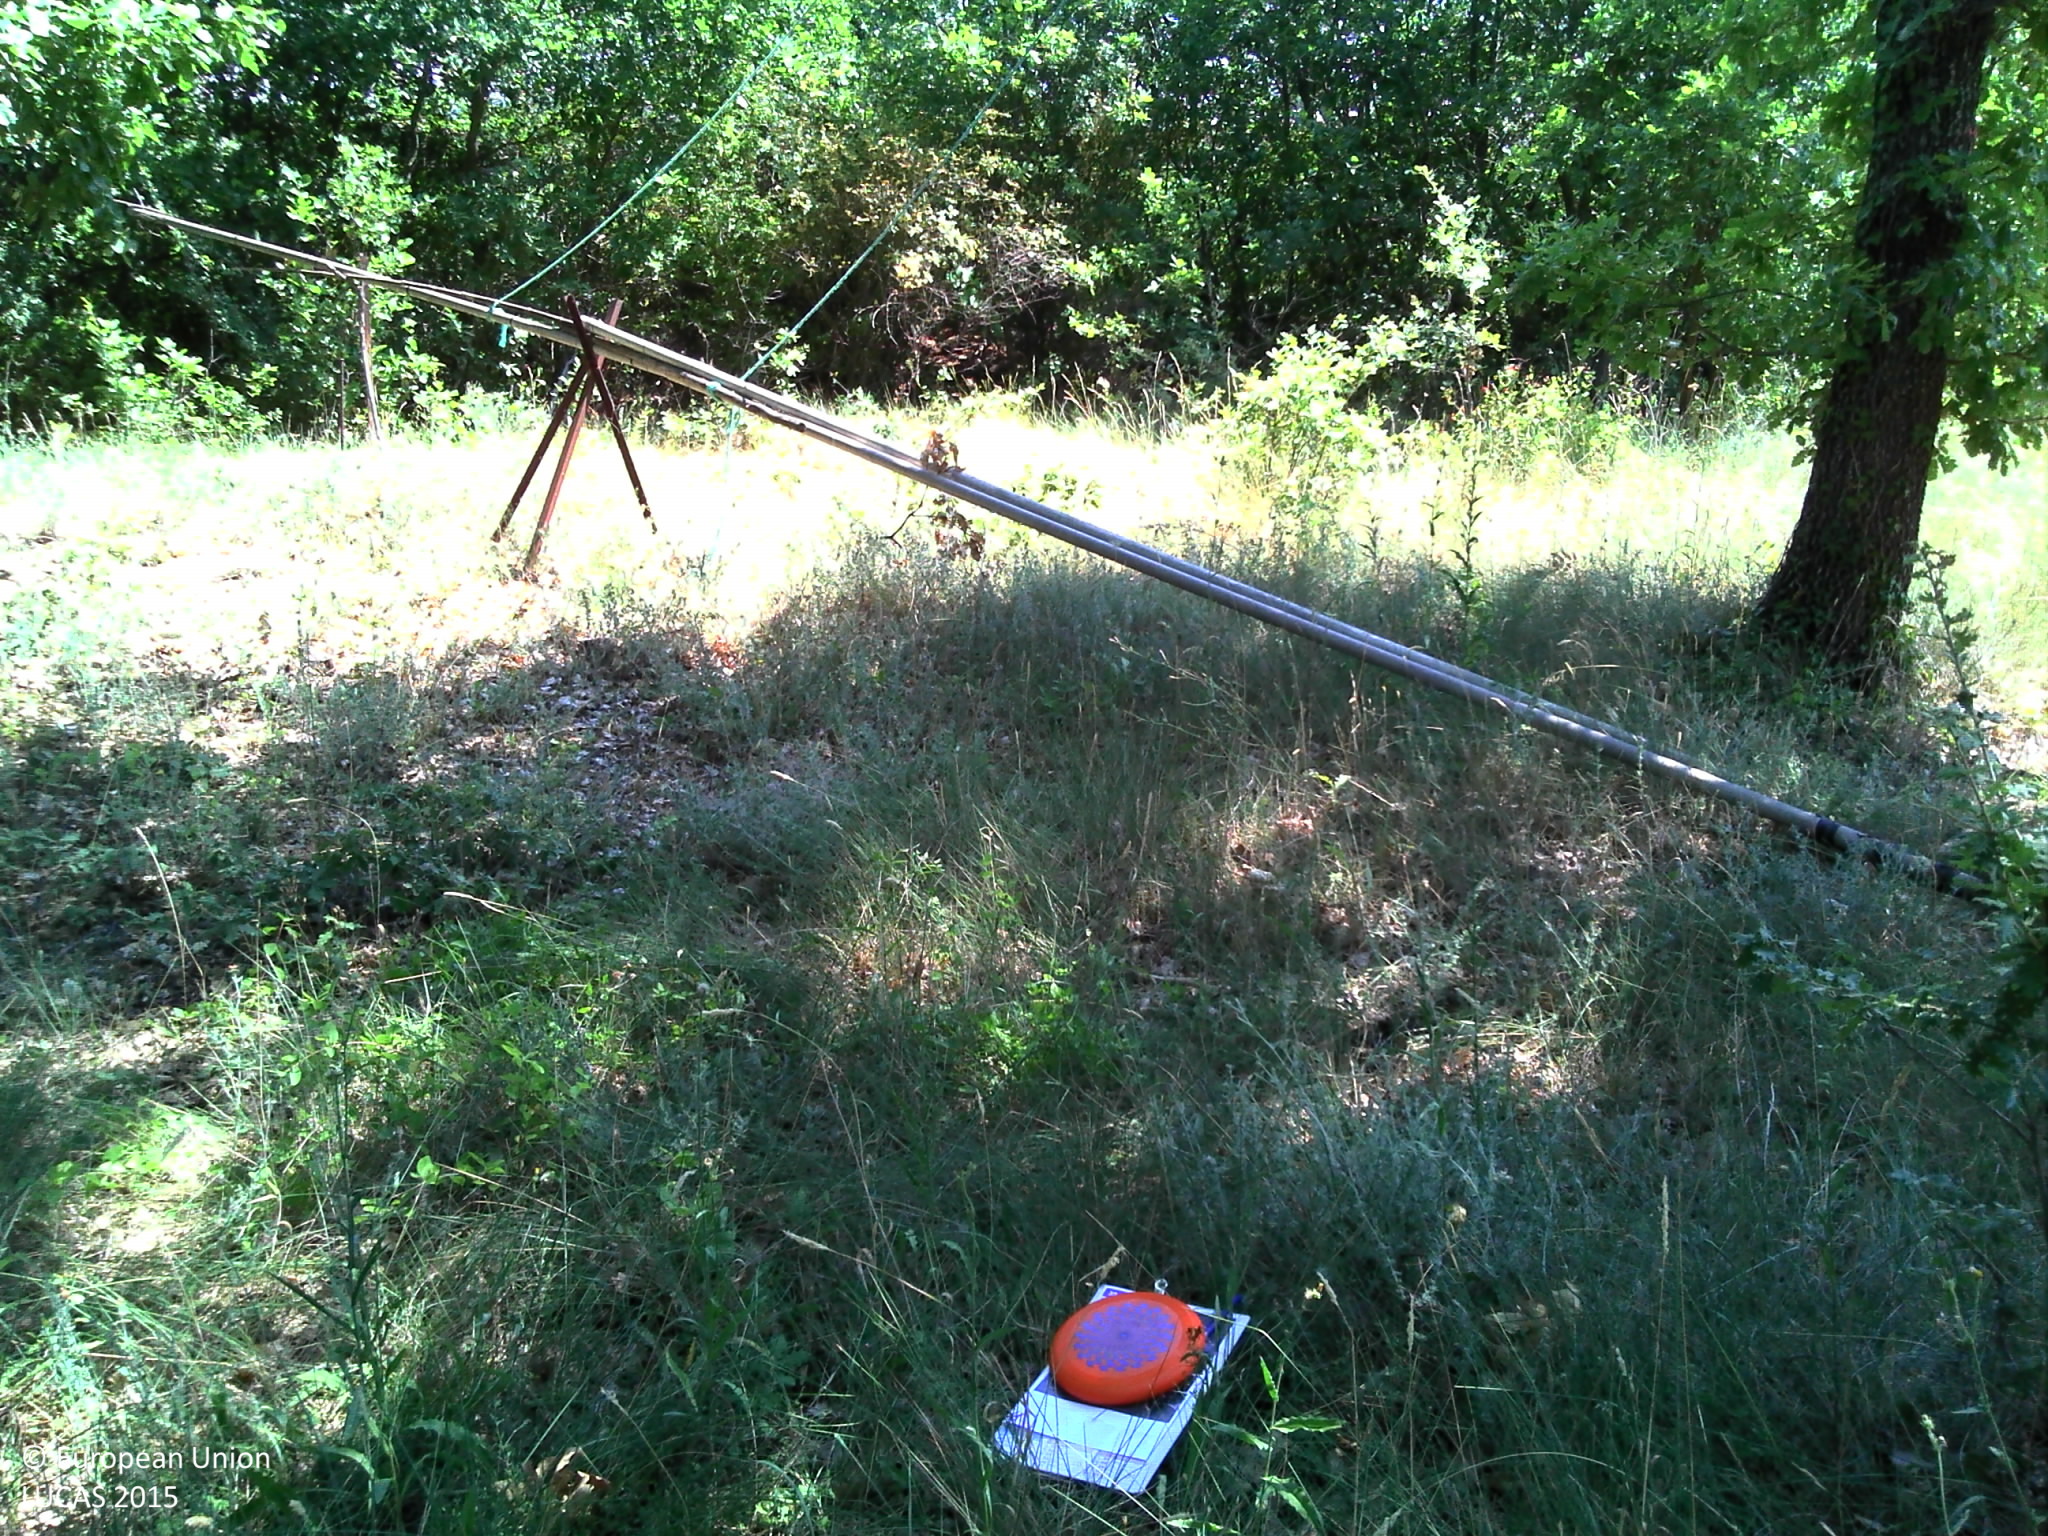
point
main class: Woodland
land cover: Broadleaved woodland
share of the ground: > 75 %
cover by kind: broadleaved forest trees 60 %, herbaceous plants 30 %, coniferous forest trees 5 %, shrubs 5 %
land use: Residential
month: August
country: FR
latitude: 43.8475
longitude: 5.3193
